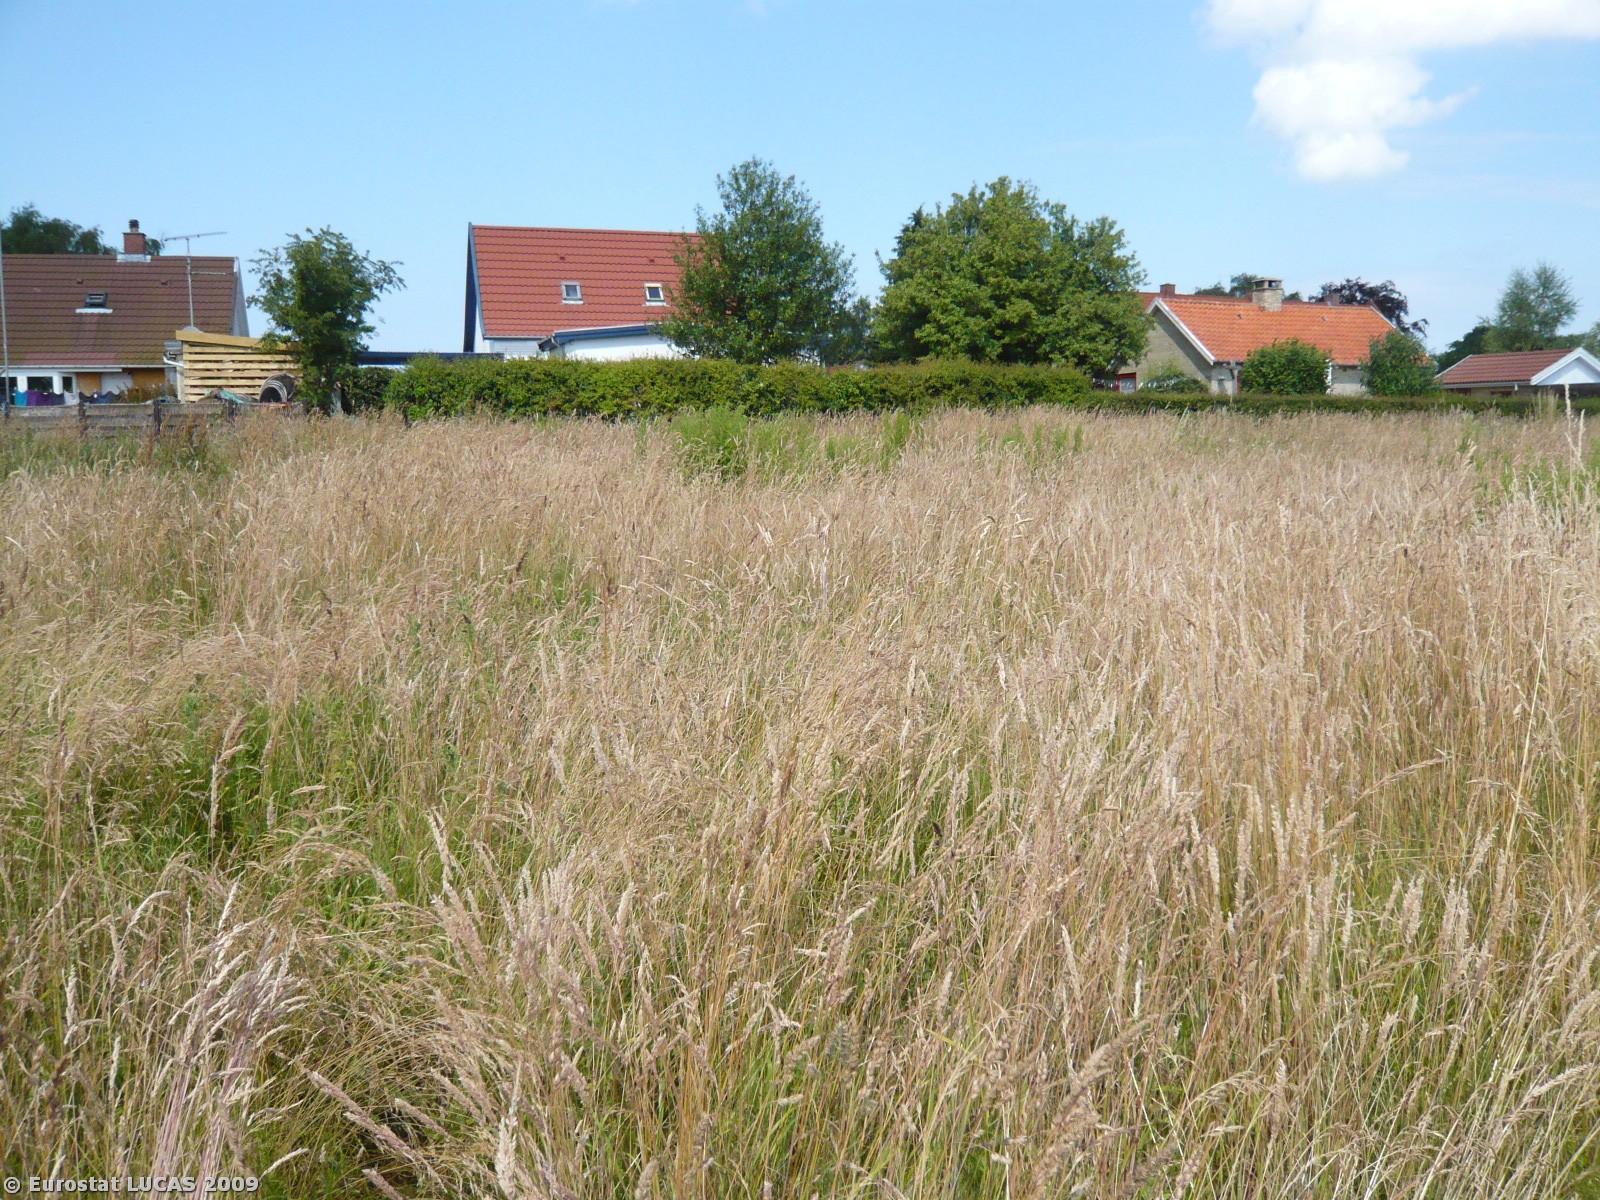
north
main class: Grassland
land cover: Grassland without tree/shrub cover
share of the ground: > 75 %
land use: Fallow land
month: July
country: DK
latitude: 55.9251
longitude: 11.6787
